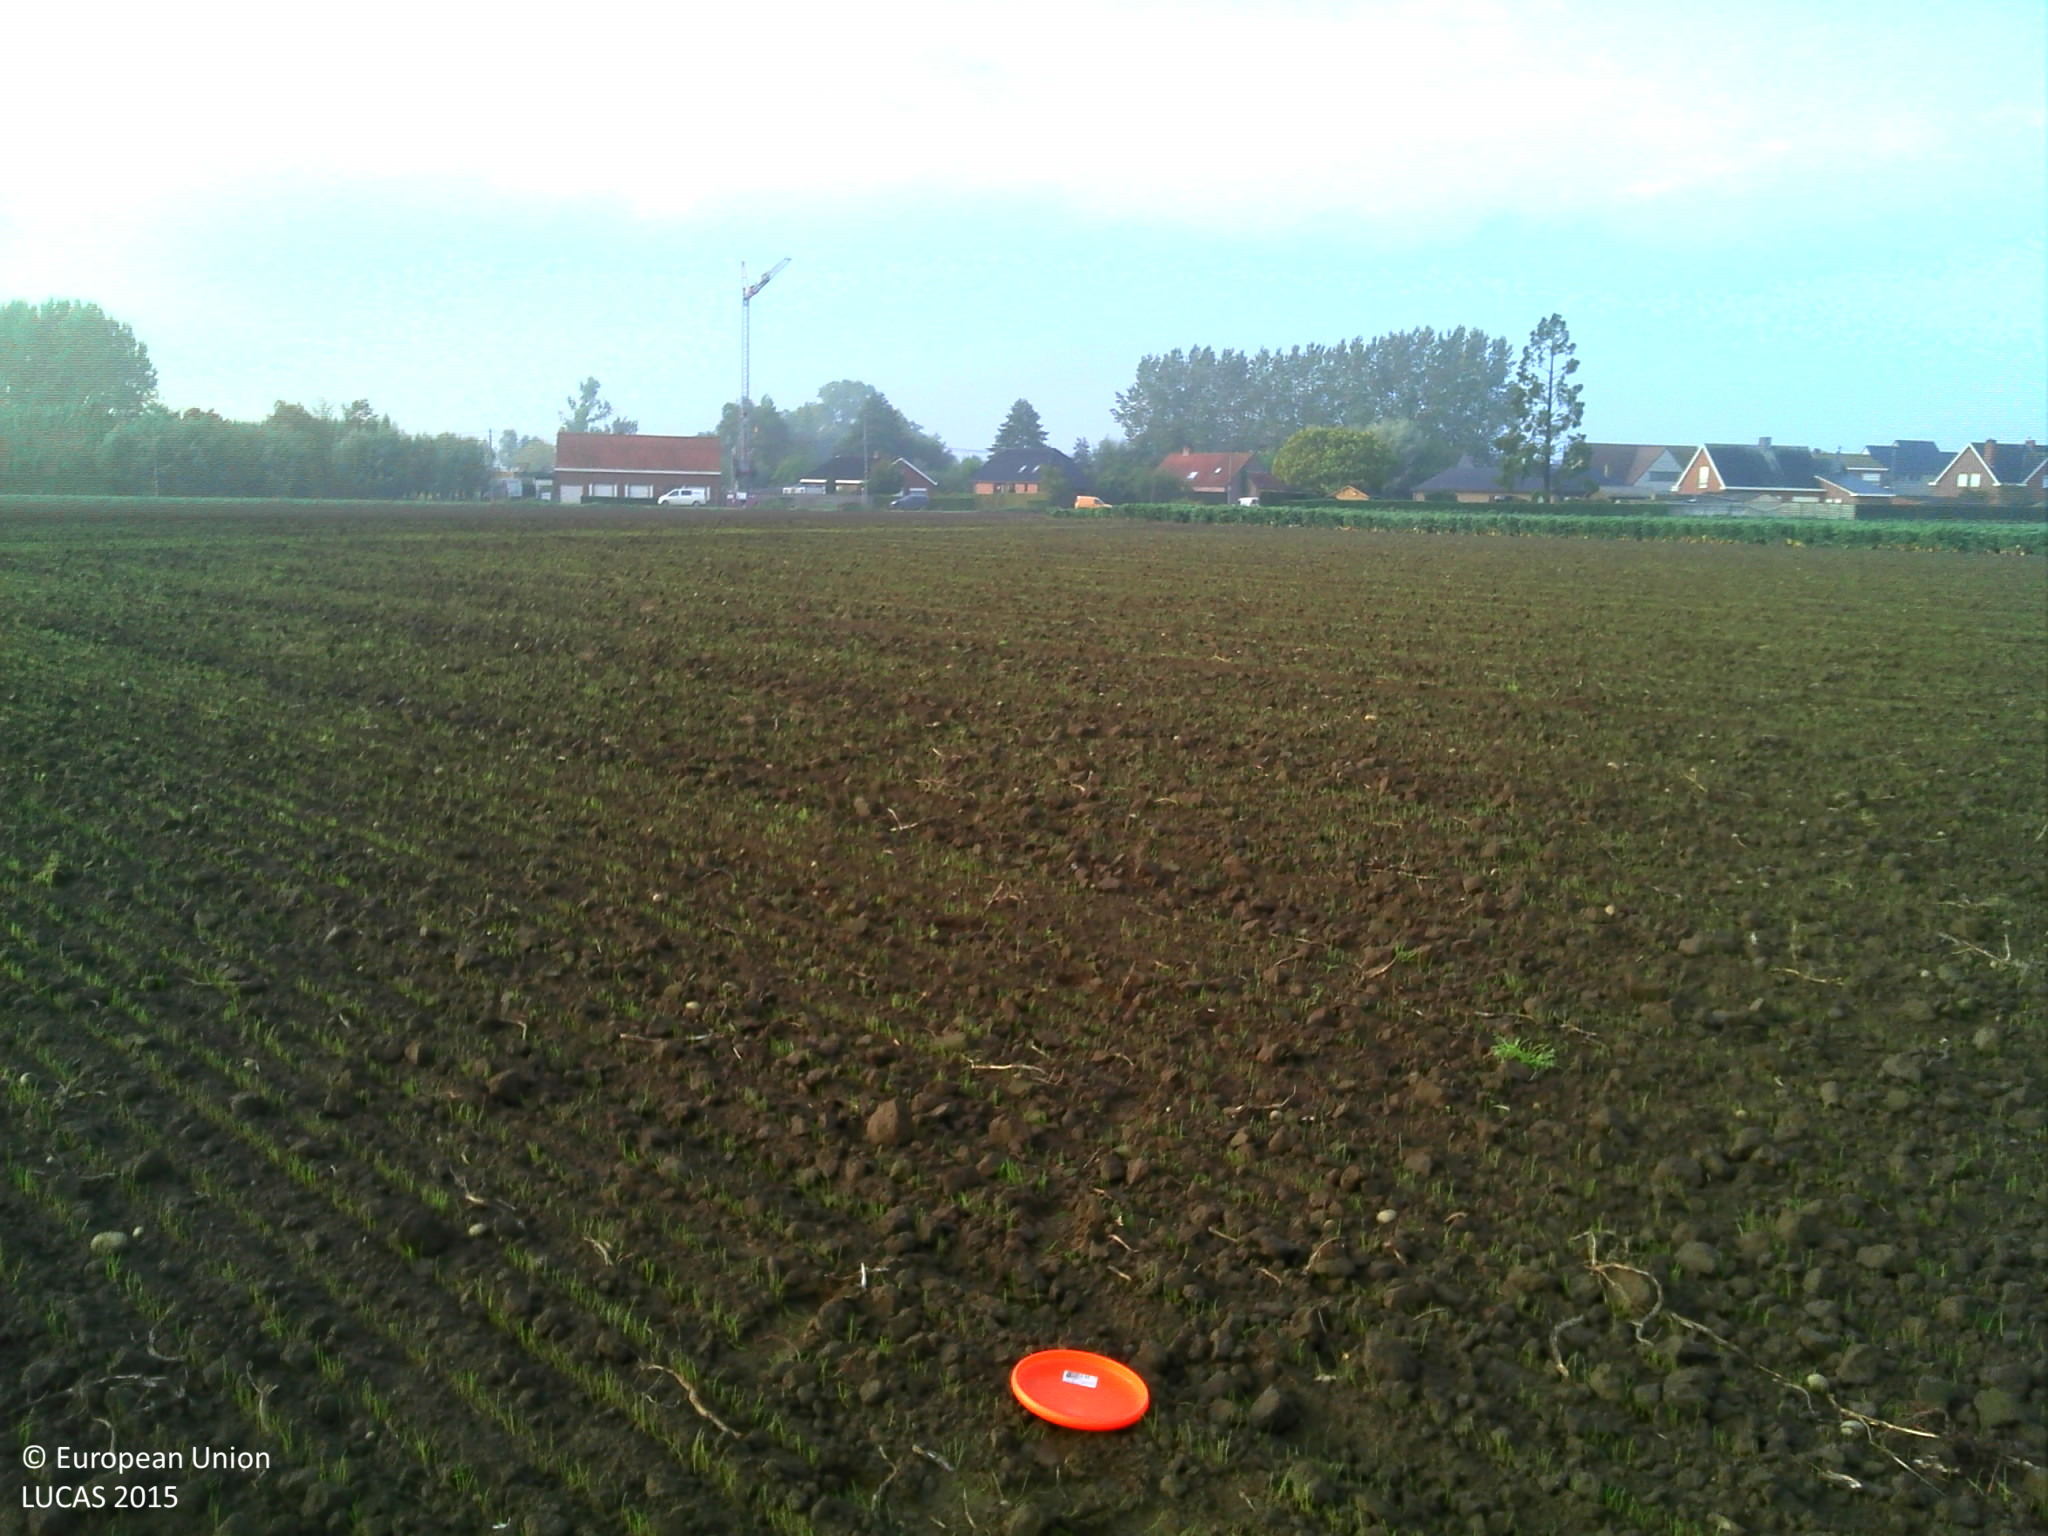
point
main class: Cropland
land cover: Temporary grasslands
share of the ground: < 10 %
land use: Agriculture (excluding fallow land and kitchen gardens)
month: October
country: BE
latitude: 50.9403
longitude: 2.9451
